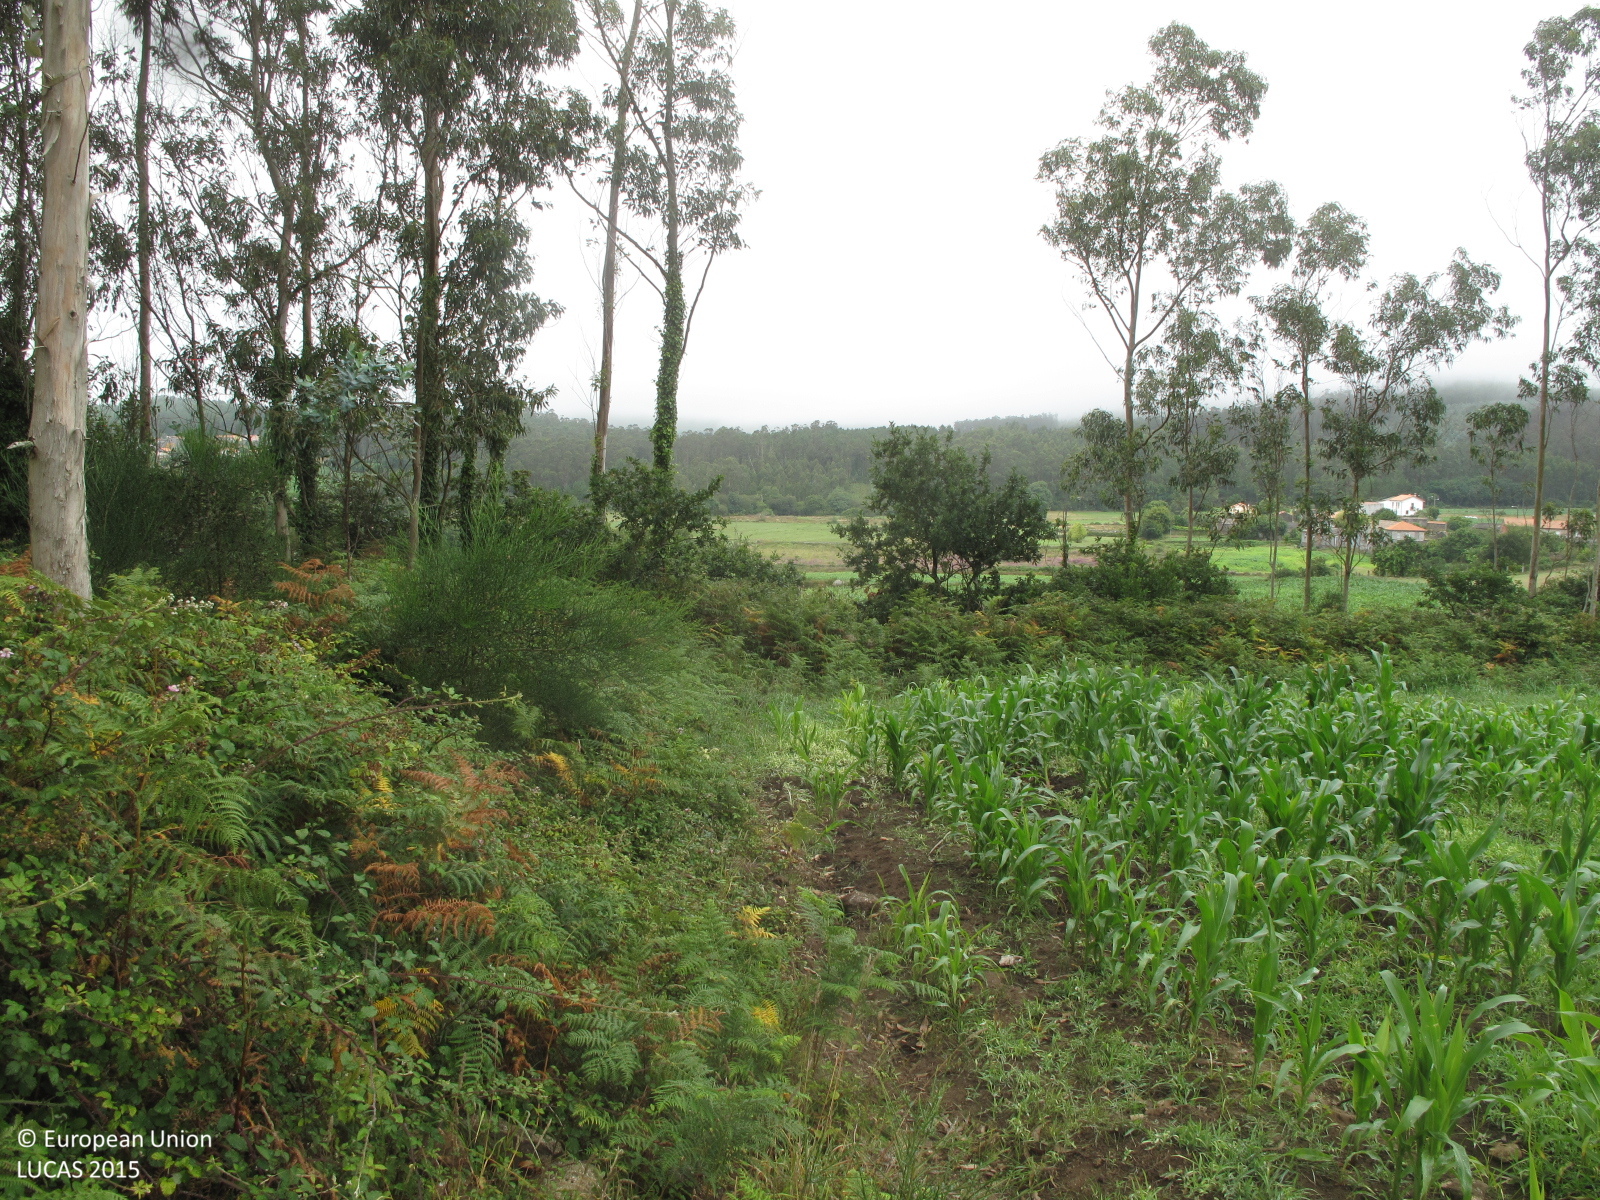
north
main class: Woodland
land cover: Broadleaved woodland
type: exotic forest
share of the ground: 50 - 75 %
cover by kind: broadleaved forest trees 50 %, shrubs 30 %, herbaceous plants 20 %
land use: Forestry
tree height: > 5 m
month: July
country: ES
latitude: 43.0289
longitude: -9.2378
